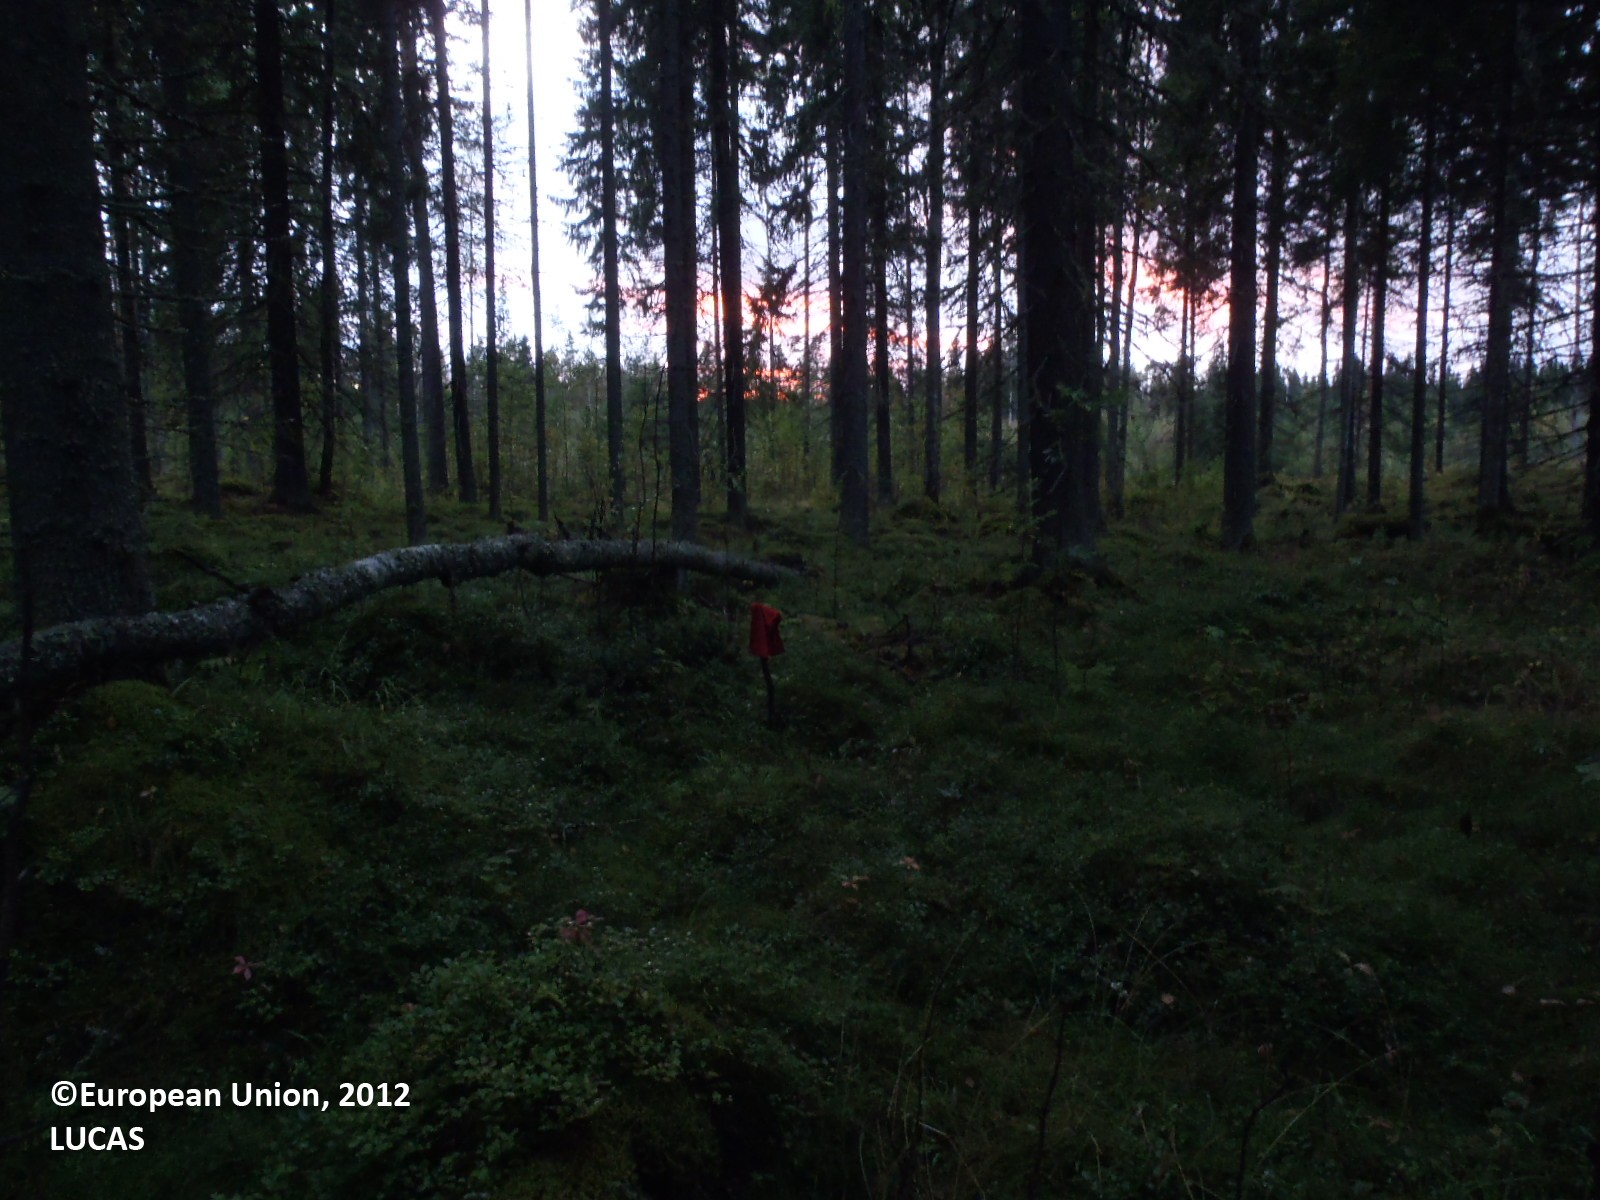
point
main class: Woodland
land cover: Spruce dominated coniferous woodland
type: boreal forest
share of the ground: > 75 %
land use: Forestry
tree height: > 5 m
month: September
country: FI
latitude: 61.7110
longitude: 22.6424
